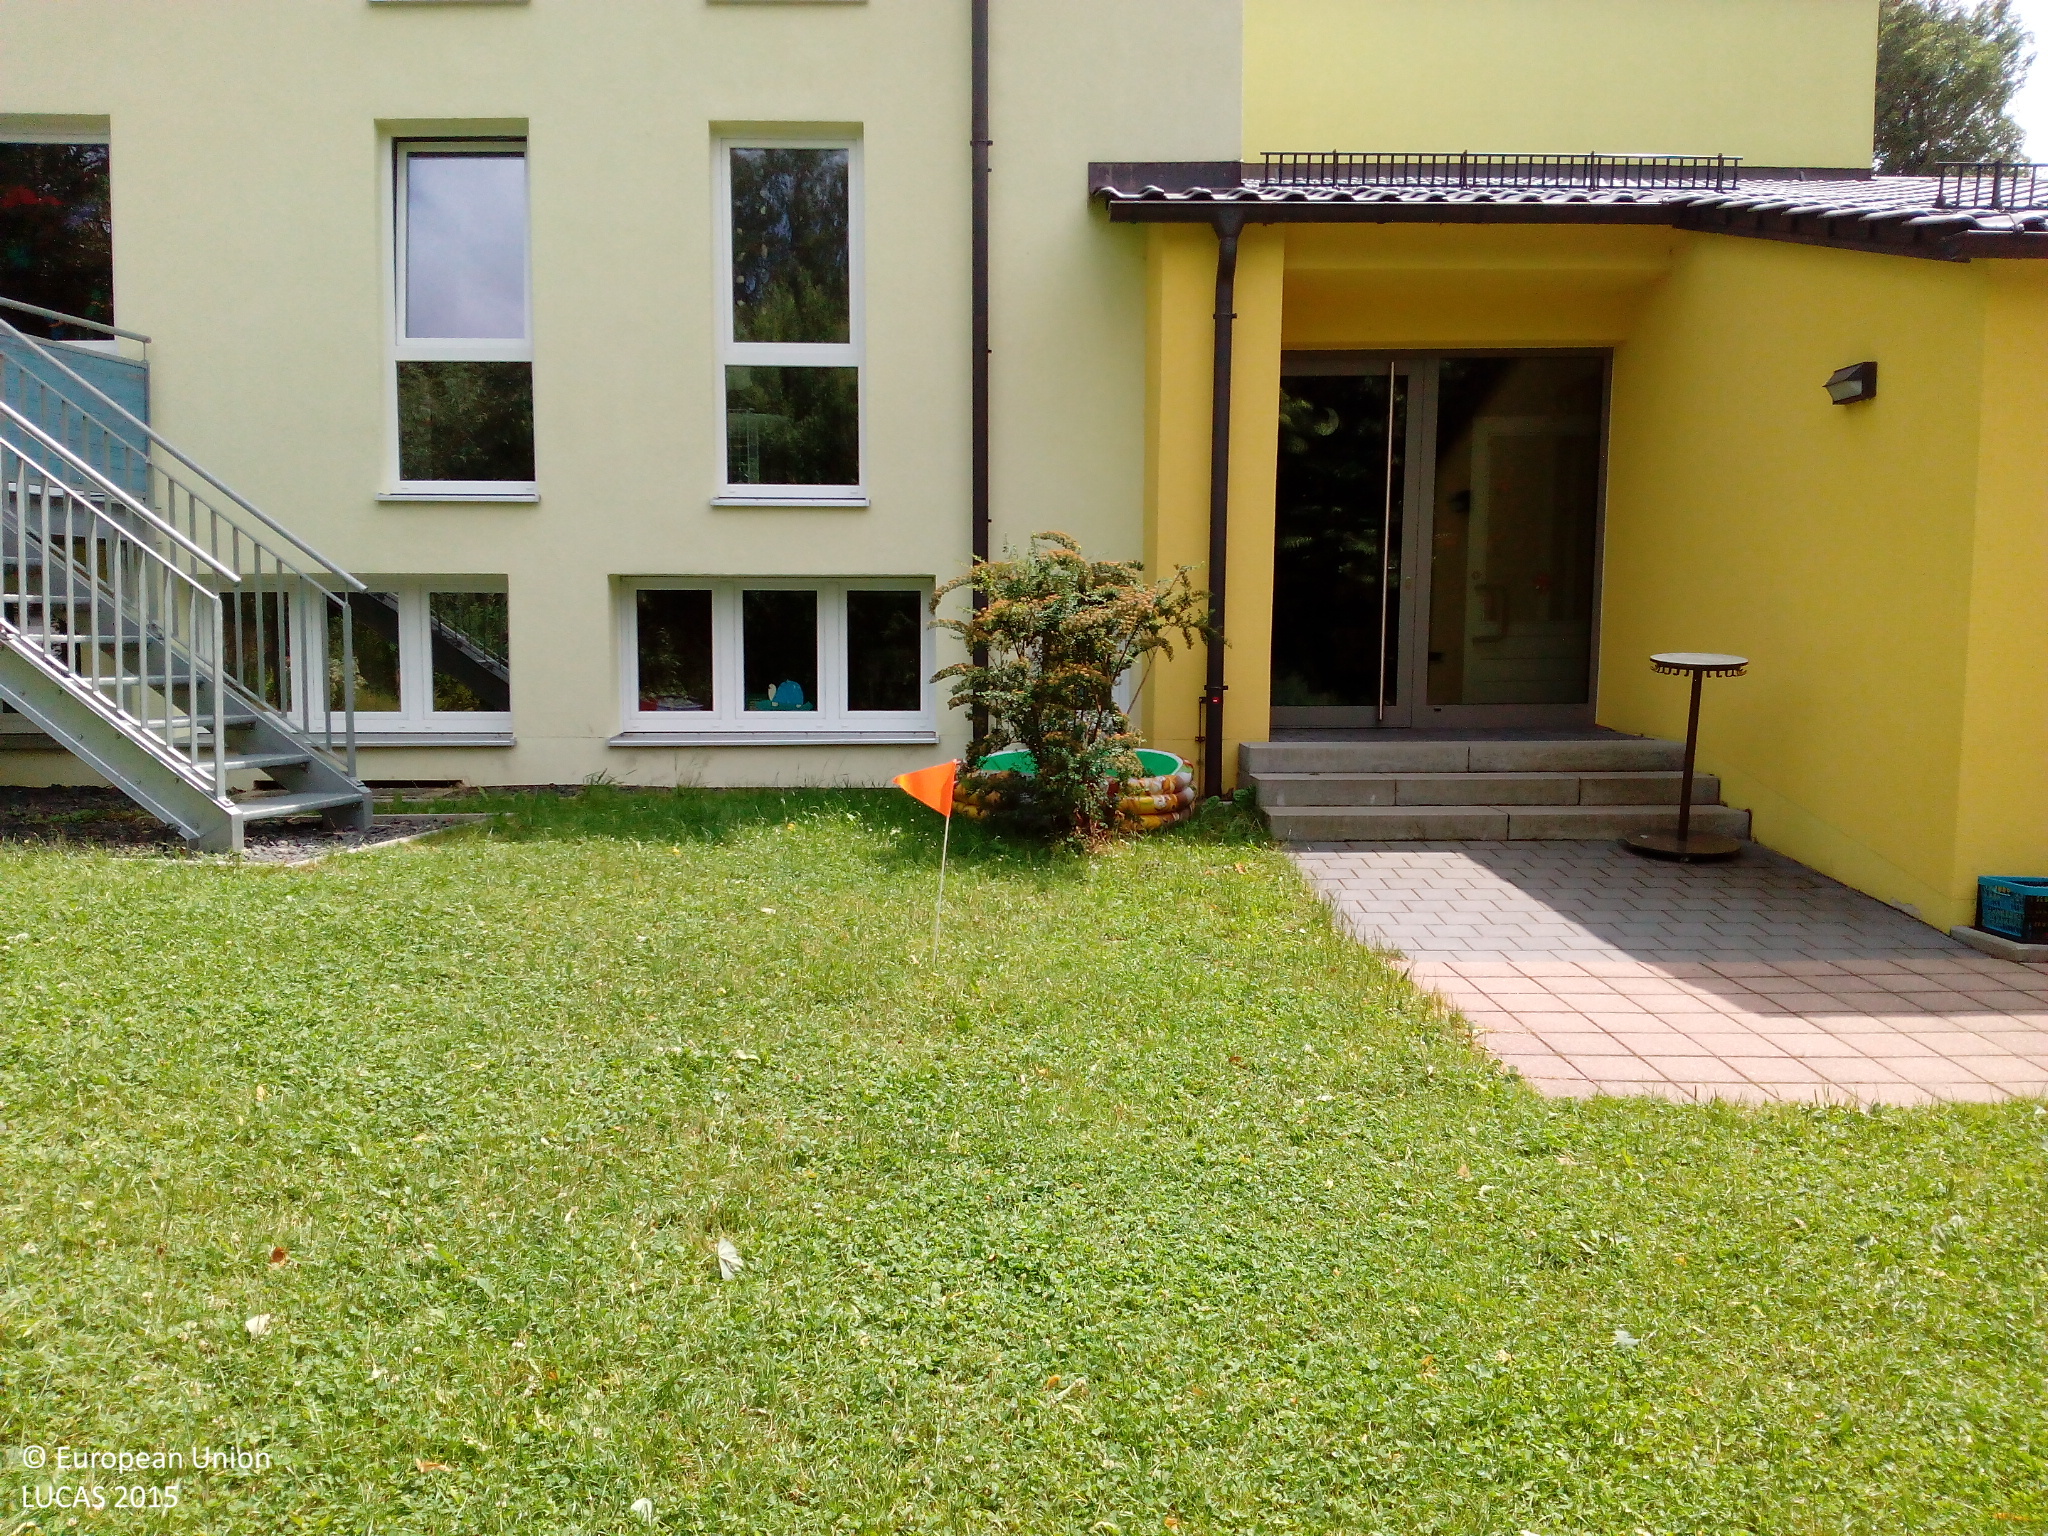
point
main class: Grassland
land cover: Grassland without tree/shrub cover
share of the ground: > 75 %
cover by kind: herbaceous plants 100 %
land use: Community services
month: July
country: DE
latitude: 49.7087
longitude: 12.4264
